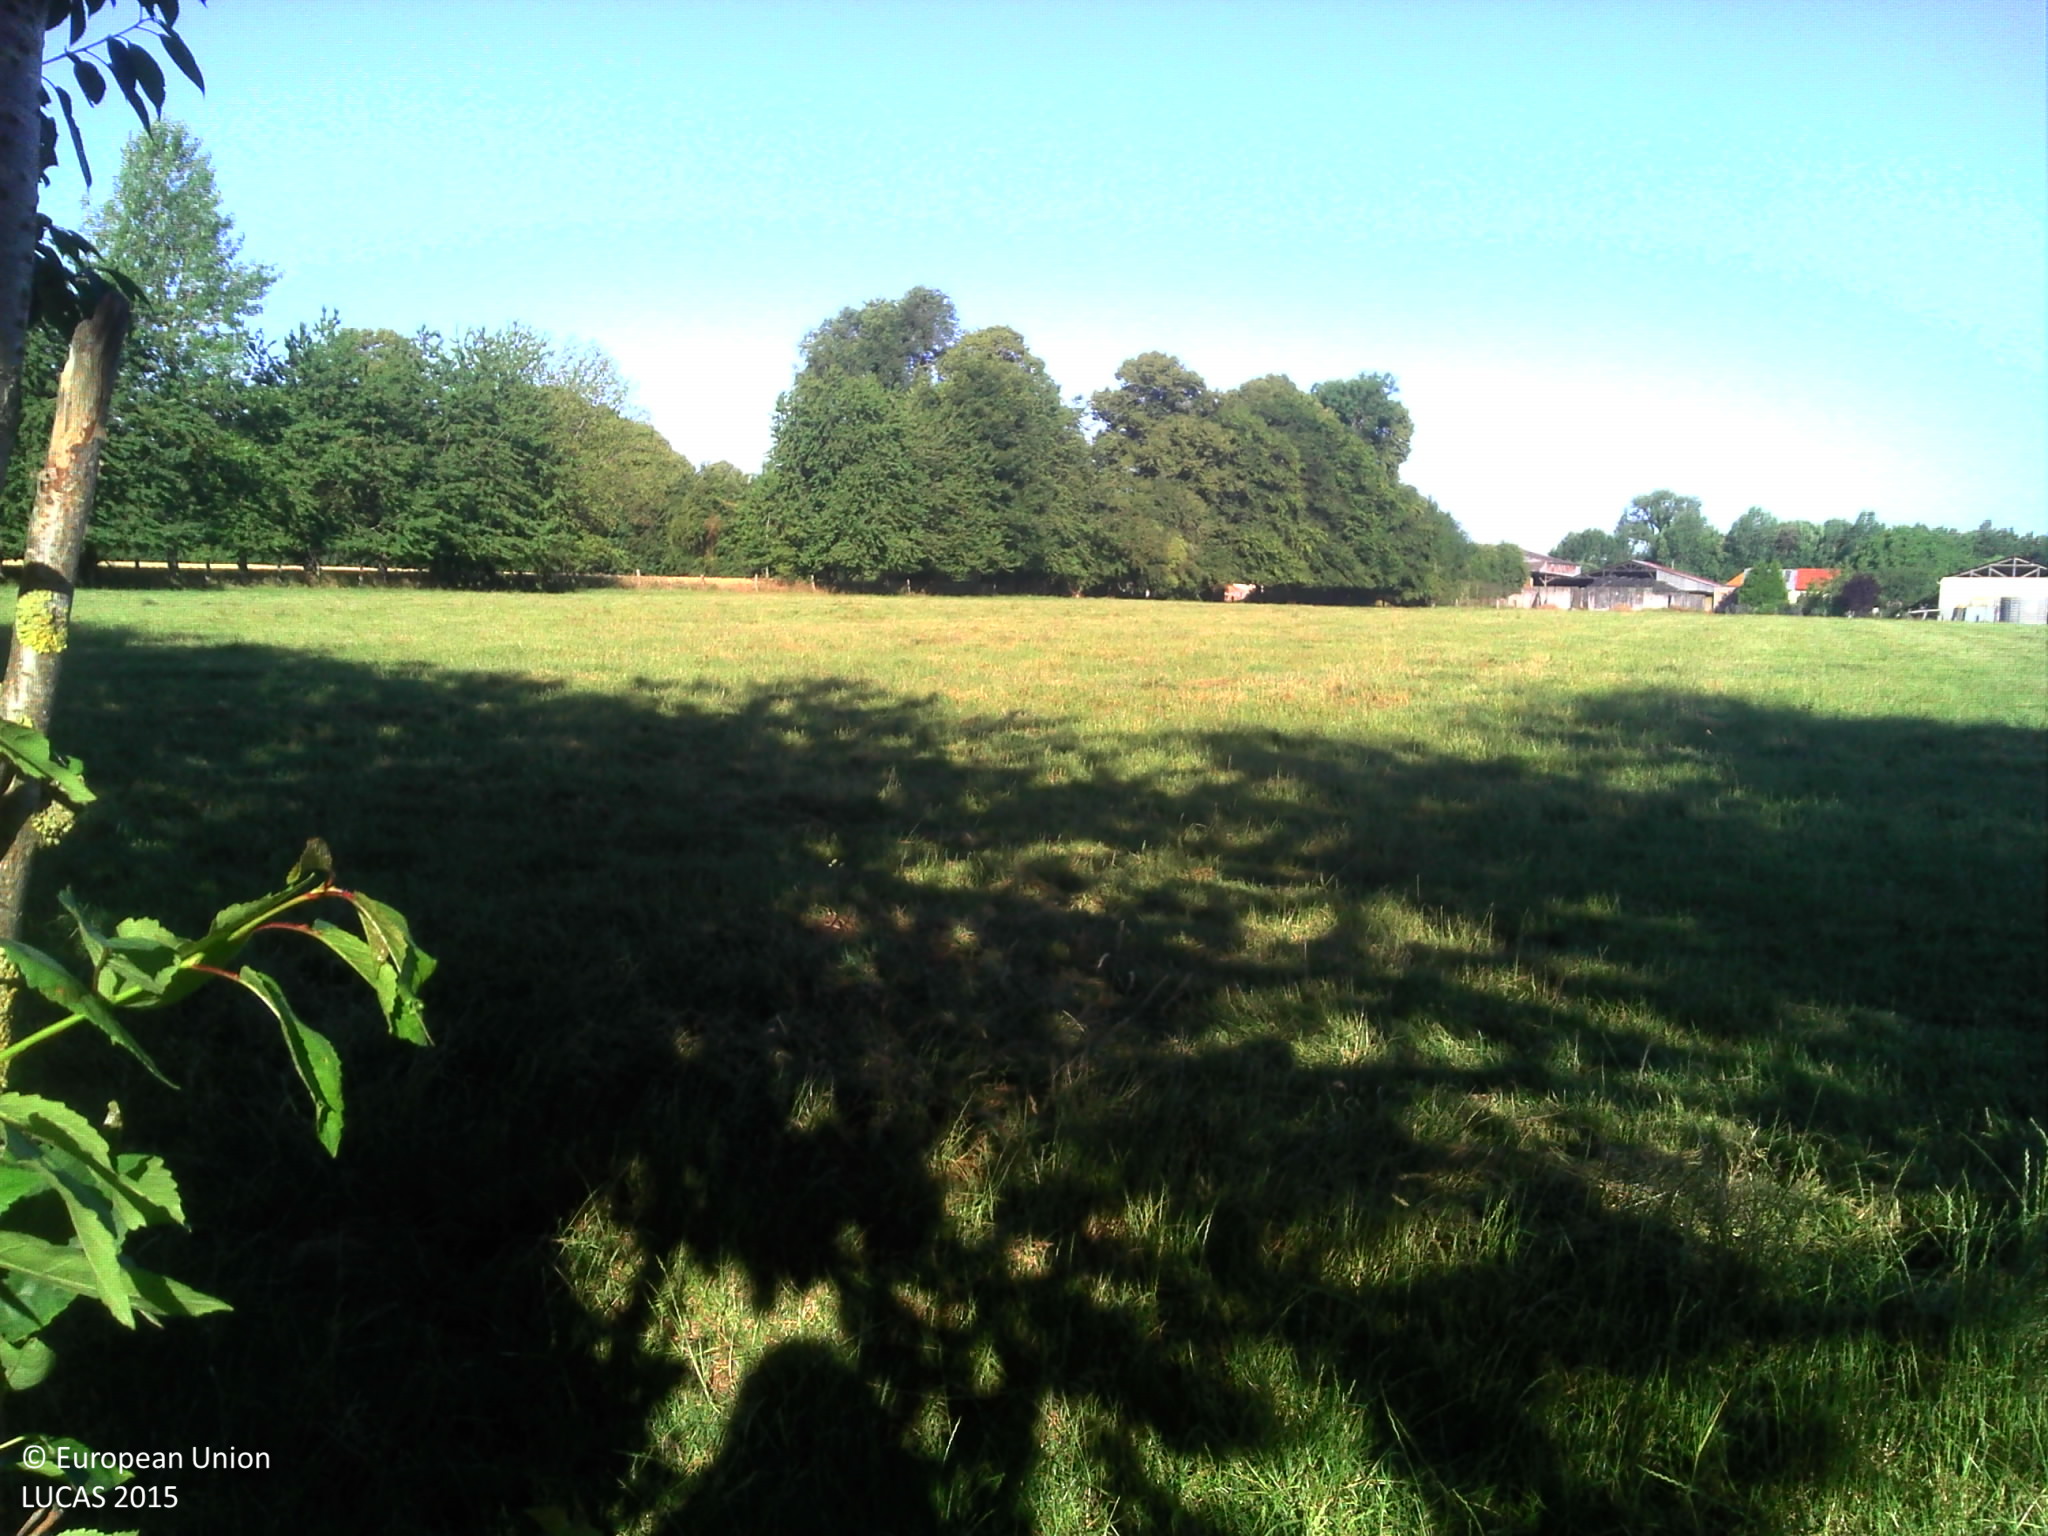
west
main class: Grassland
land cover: Grassland without tree/shrub cover
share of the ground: > 75 %
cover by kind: herbaceous plants 100 %
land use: Agriculture (excluding fallow land and kitchen gardens)
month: July
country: FR
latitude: 49.9528
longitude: 1.6897
